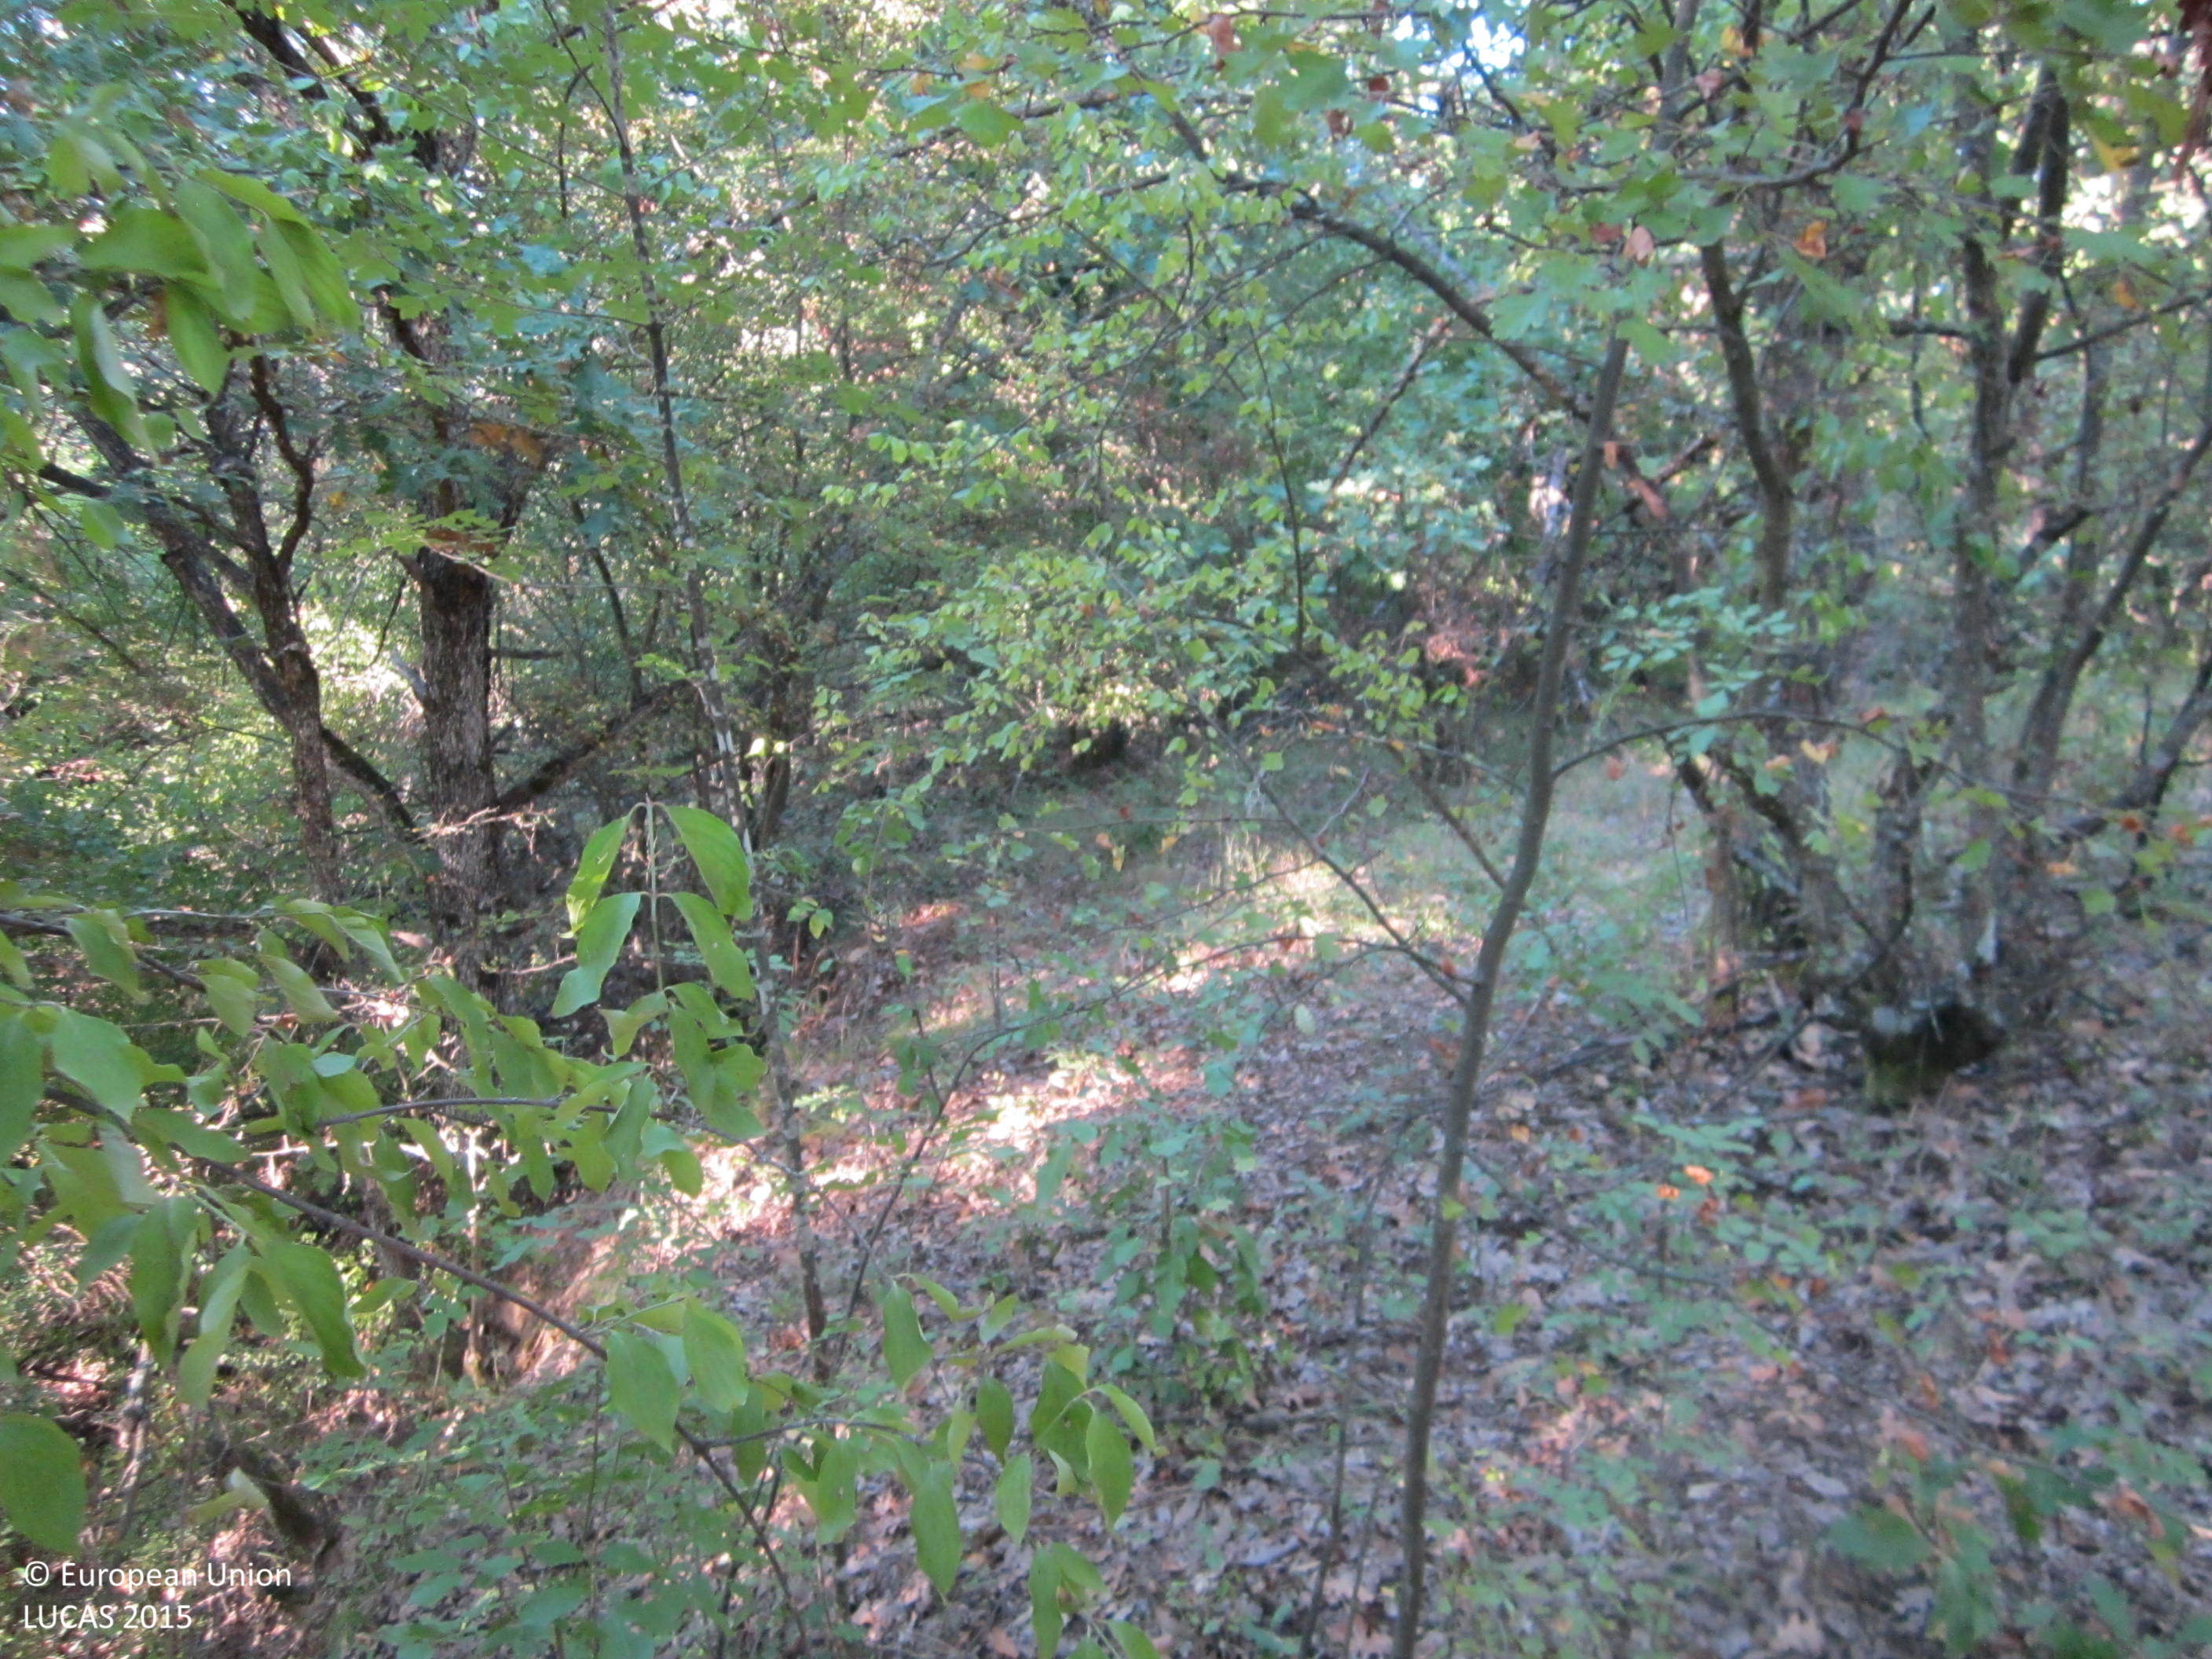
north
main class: Woodland
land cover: Broadleaved woodland
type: thermophilous deciduous forest
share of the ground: 50 - 75 %
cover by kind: broadleaved forest trees 70 %, unconsolidated bare surface 20 %, shrubs 5 %, herbaceous plants 5 %
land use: Forestry
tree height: > 5 m
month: September
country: BG
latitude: 42.1052
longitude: 27.1167
